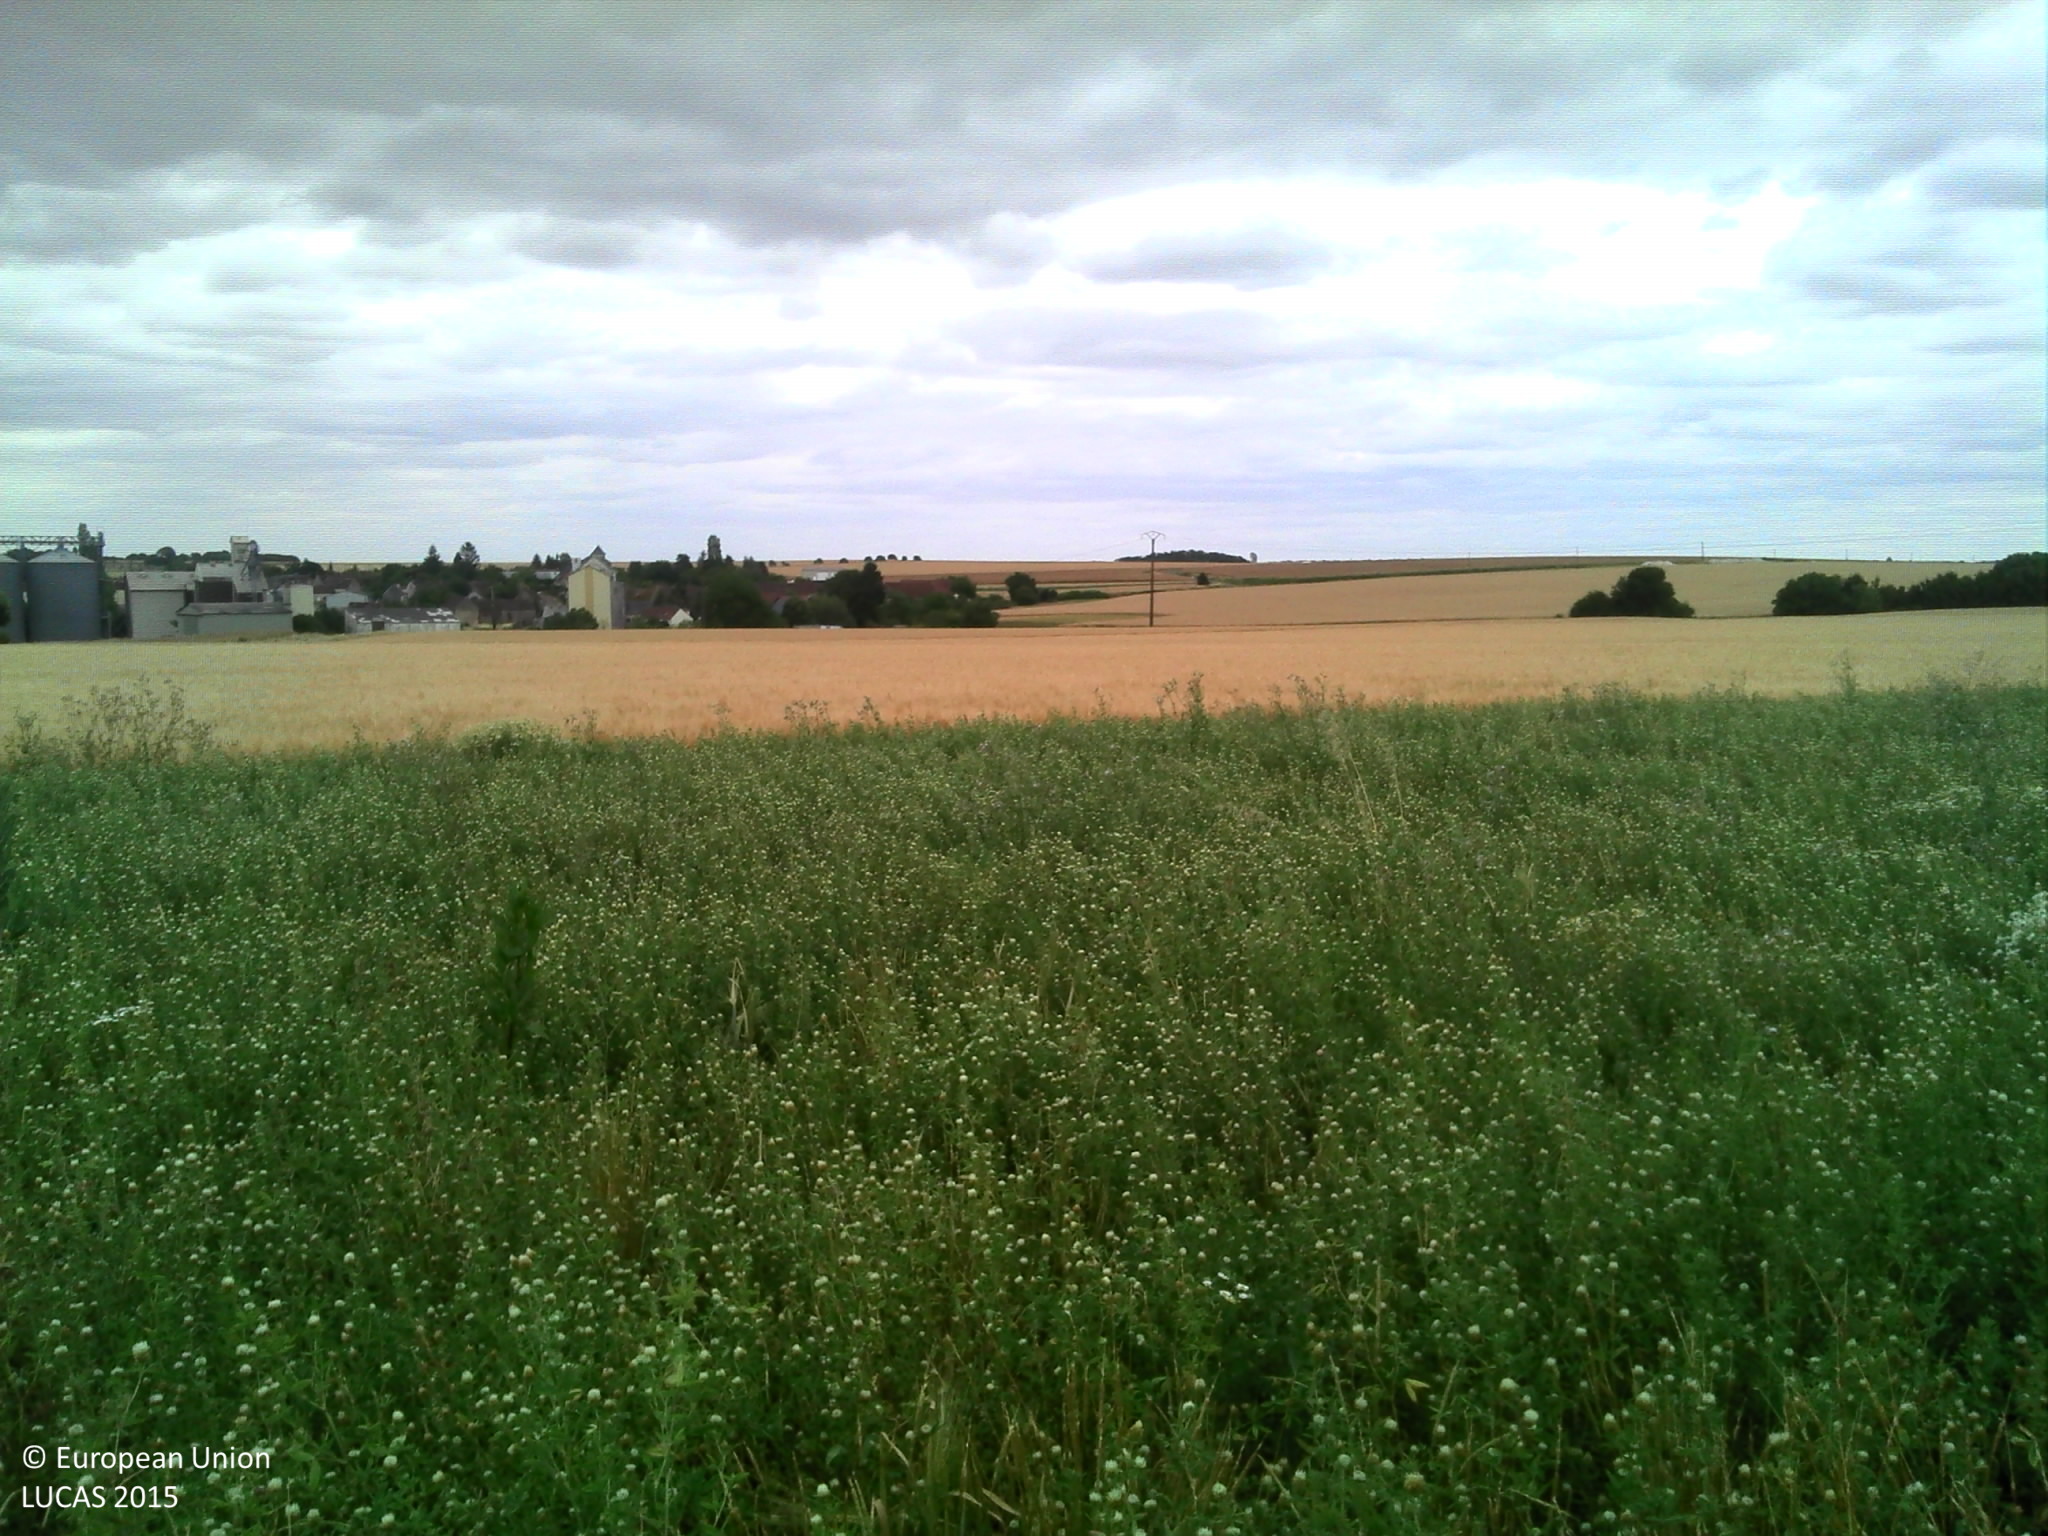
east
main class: Cropland
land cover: Rape and turnip rape
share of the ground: > 75 %
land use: Agriculture (excluding fallow land and kitchen gardens)
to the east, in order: Rape and turnip rape; Other fibre and oleaginous crops; Barley; Common wheat
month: July
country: FR
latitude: 48.3504
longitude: 3.3952
